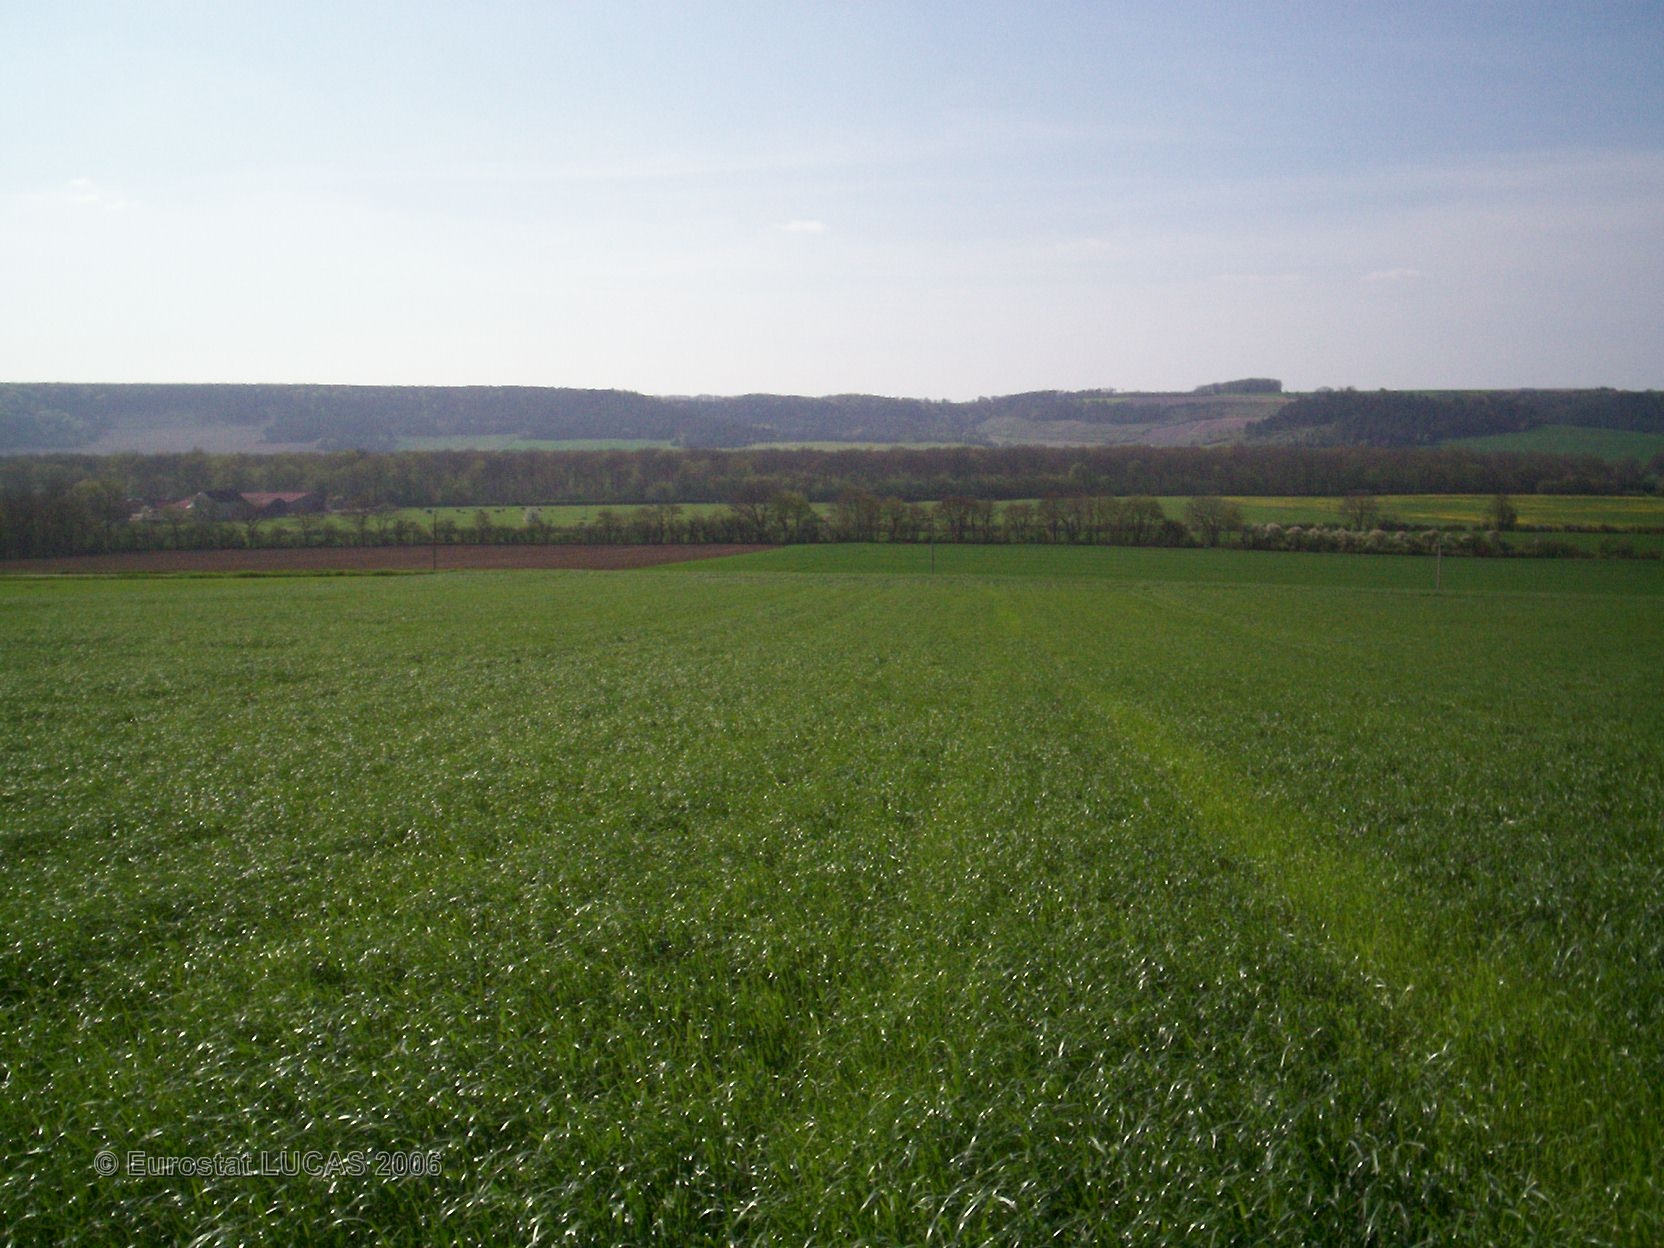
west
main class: Cropland
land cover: Barley
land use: Agriculture (excluding fallow land and kitchen gardens)
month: April
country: FR
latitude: 47.9072
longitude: 4.5264
